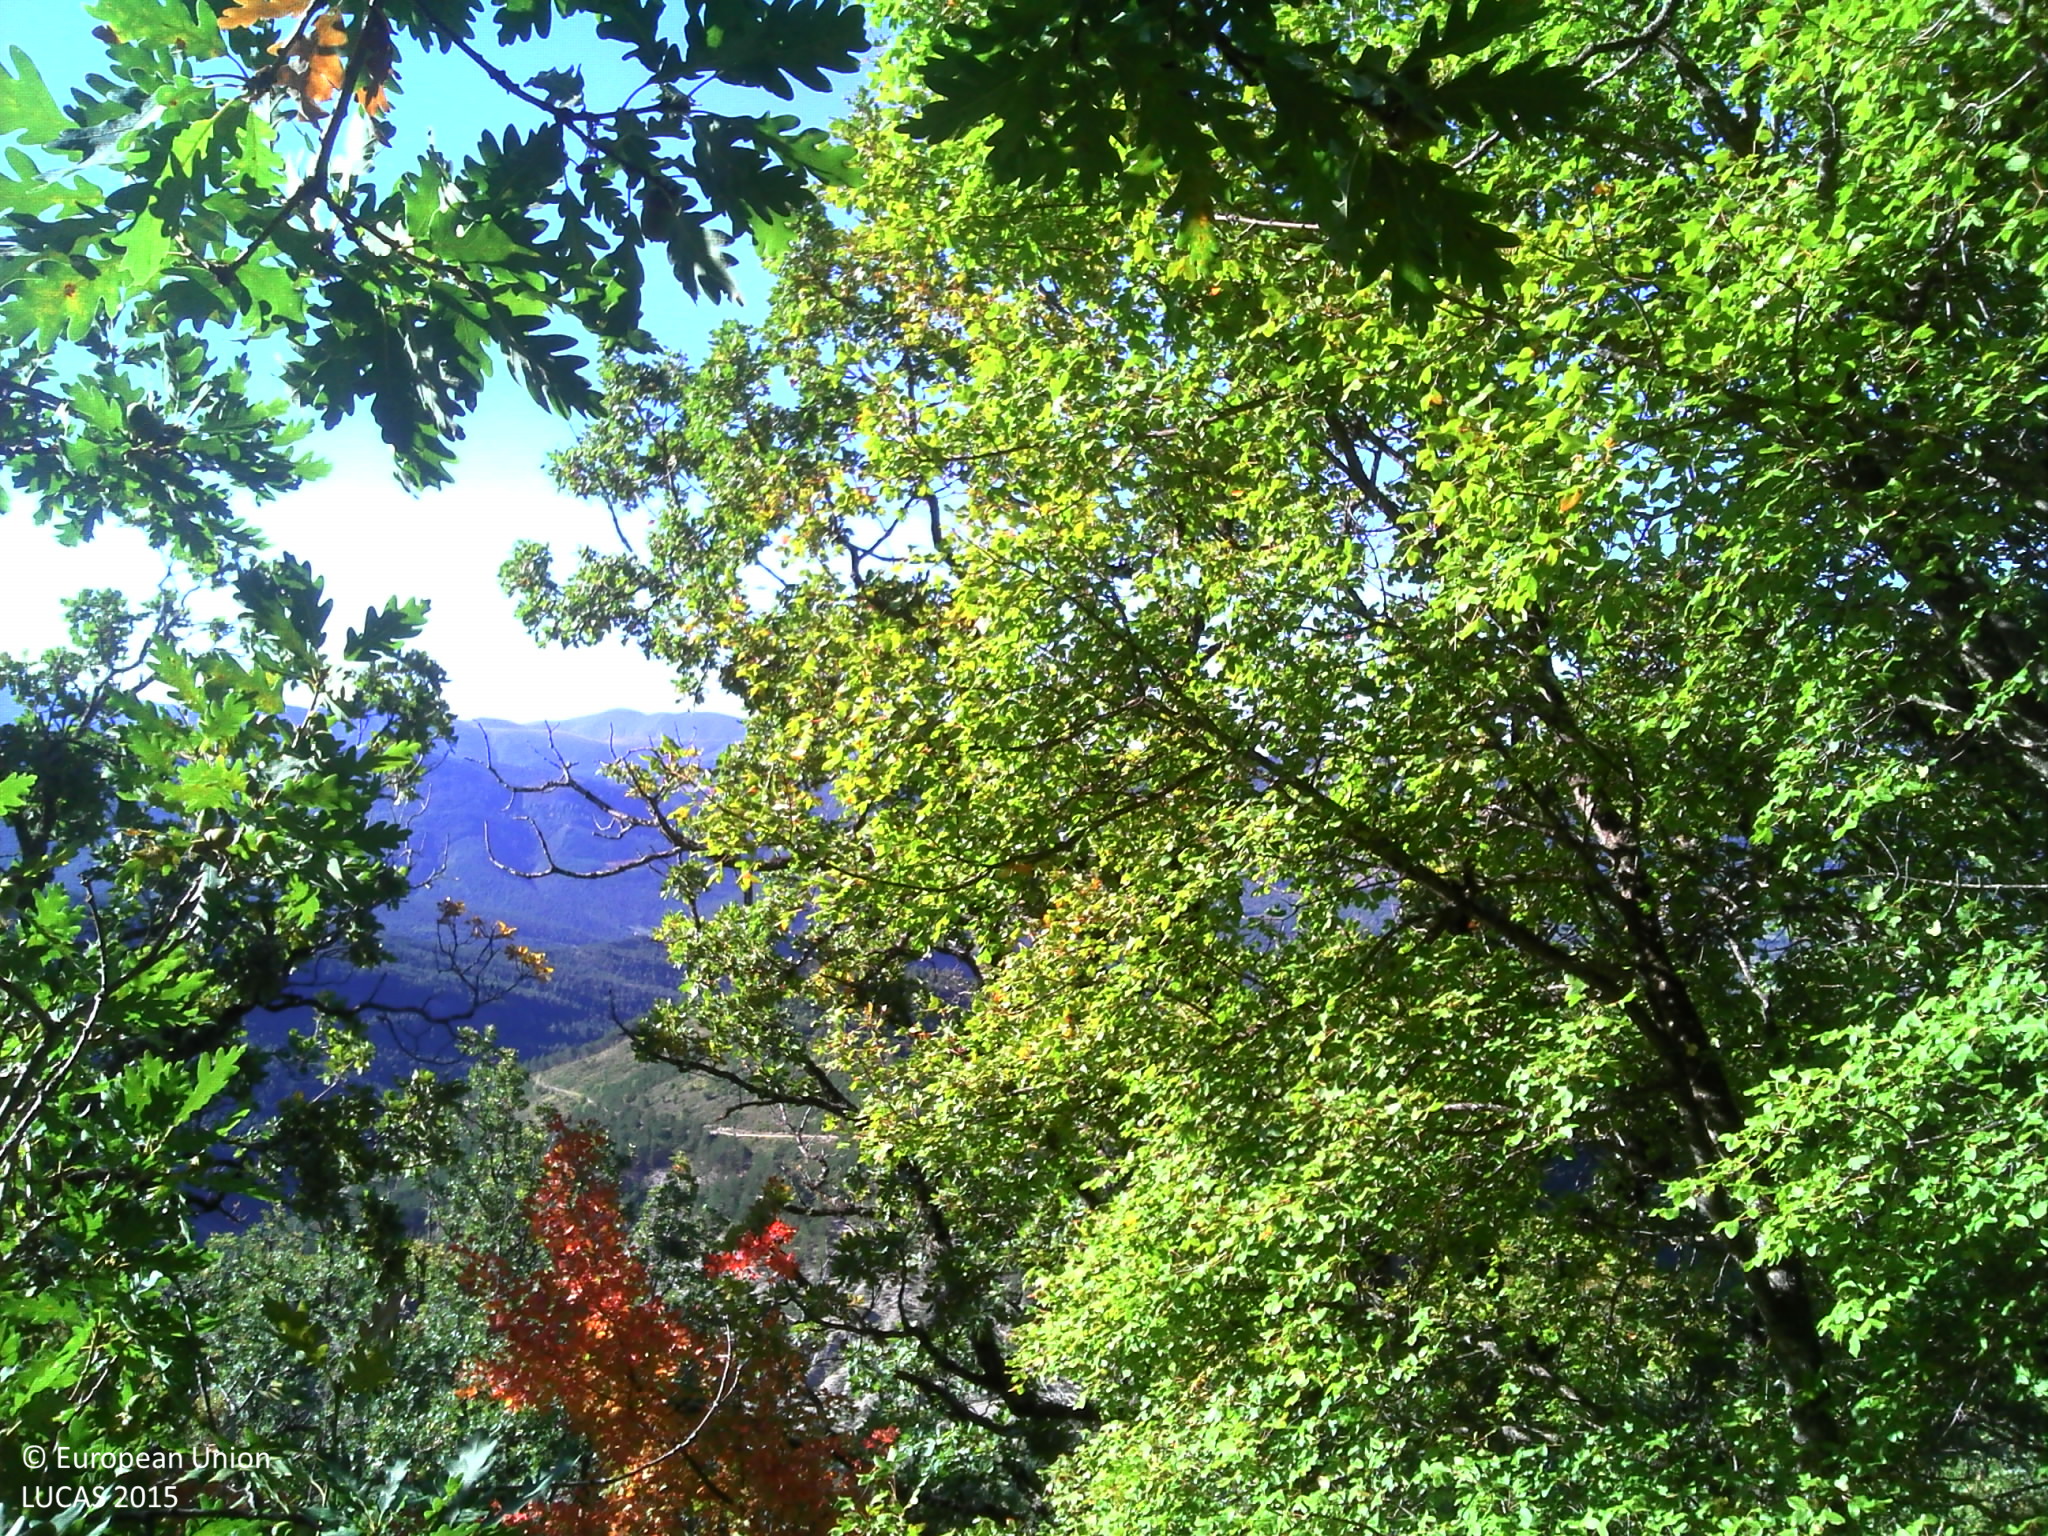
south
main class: Woodland
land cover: Broadleaved woodland
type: thermophilous deciduous forest
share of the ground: > 75 %
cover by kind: broadleaved forest trees 75 %, herbaceous plants 20 %, coniferous forest trees 5 %
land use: Semi-natural and natural areas not in use
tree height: > 5 m
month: September
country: FR
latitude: 44.3075
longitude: 5.5071
